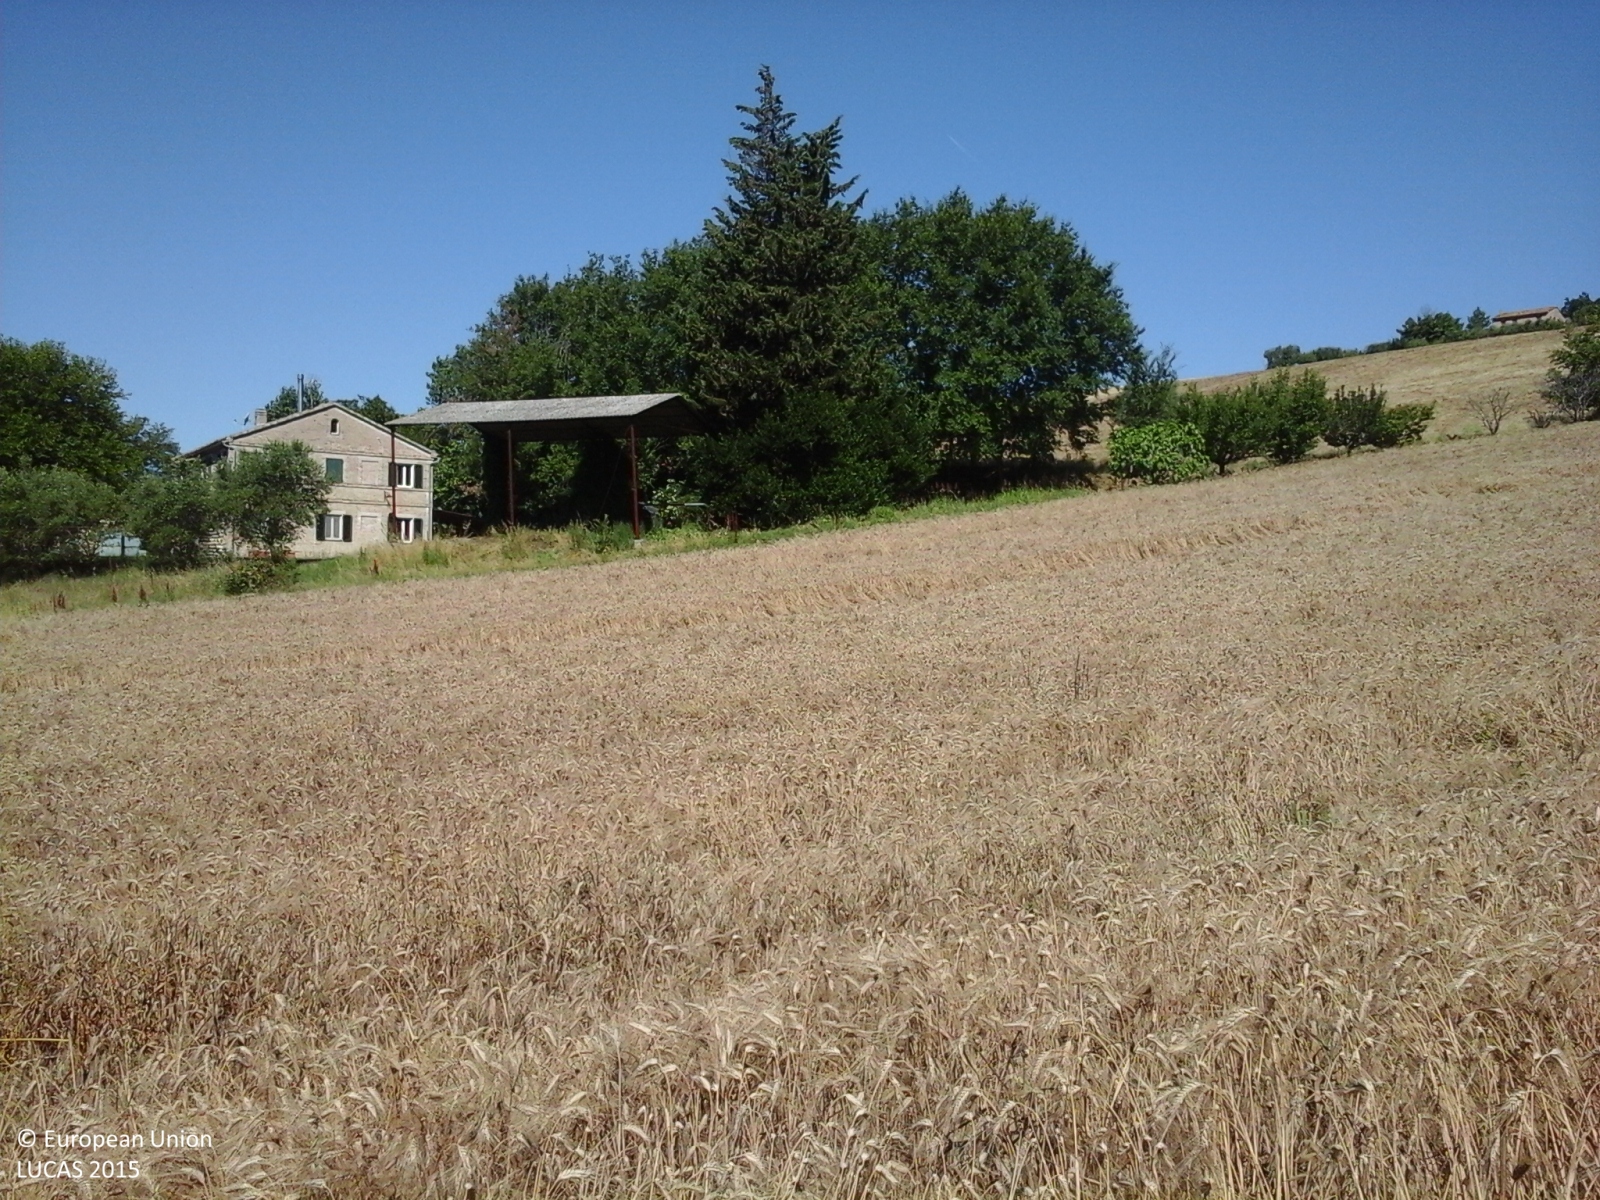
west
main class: Cropland
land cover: Durum wheat
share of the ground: > 75 %
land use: Agriculture (excluding fallow land and kitchen gardens)
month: June
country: IT
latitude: 43.3916
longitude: 13.4111
